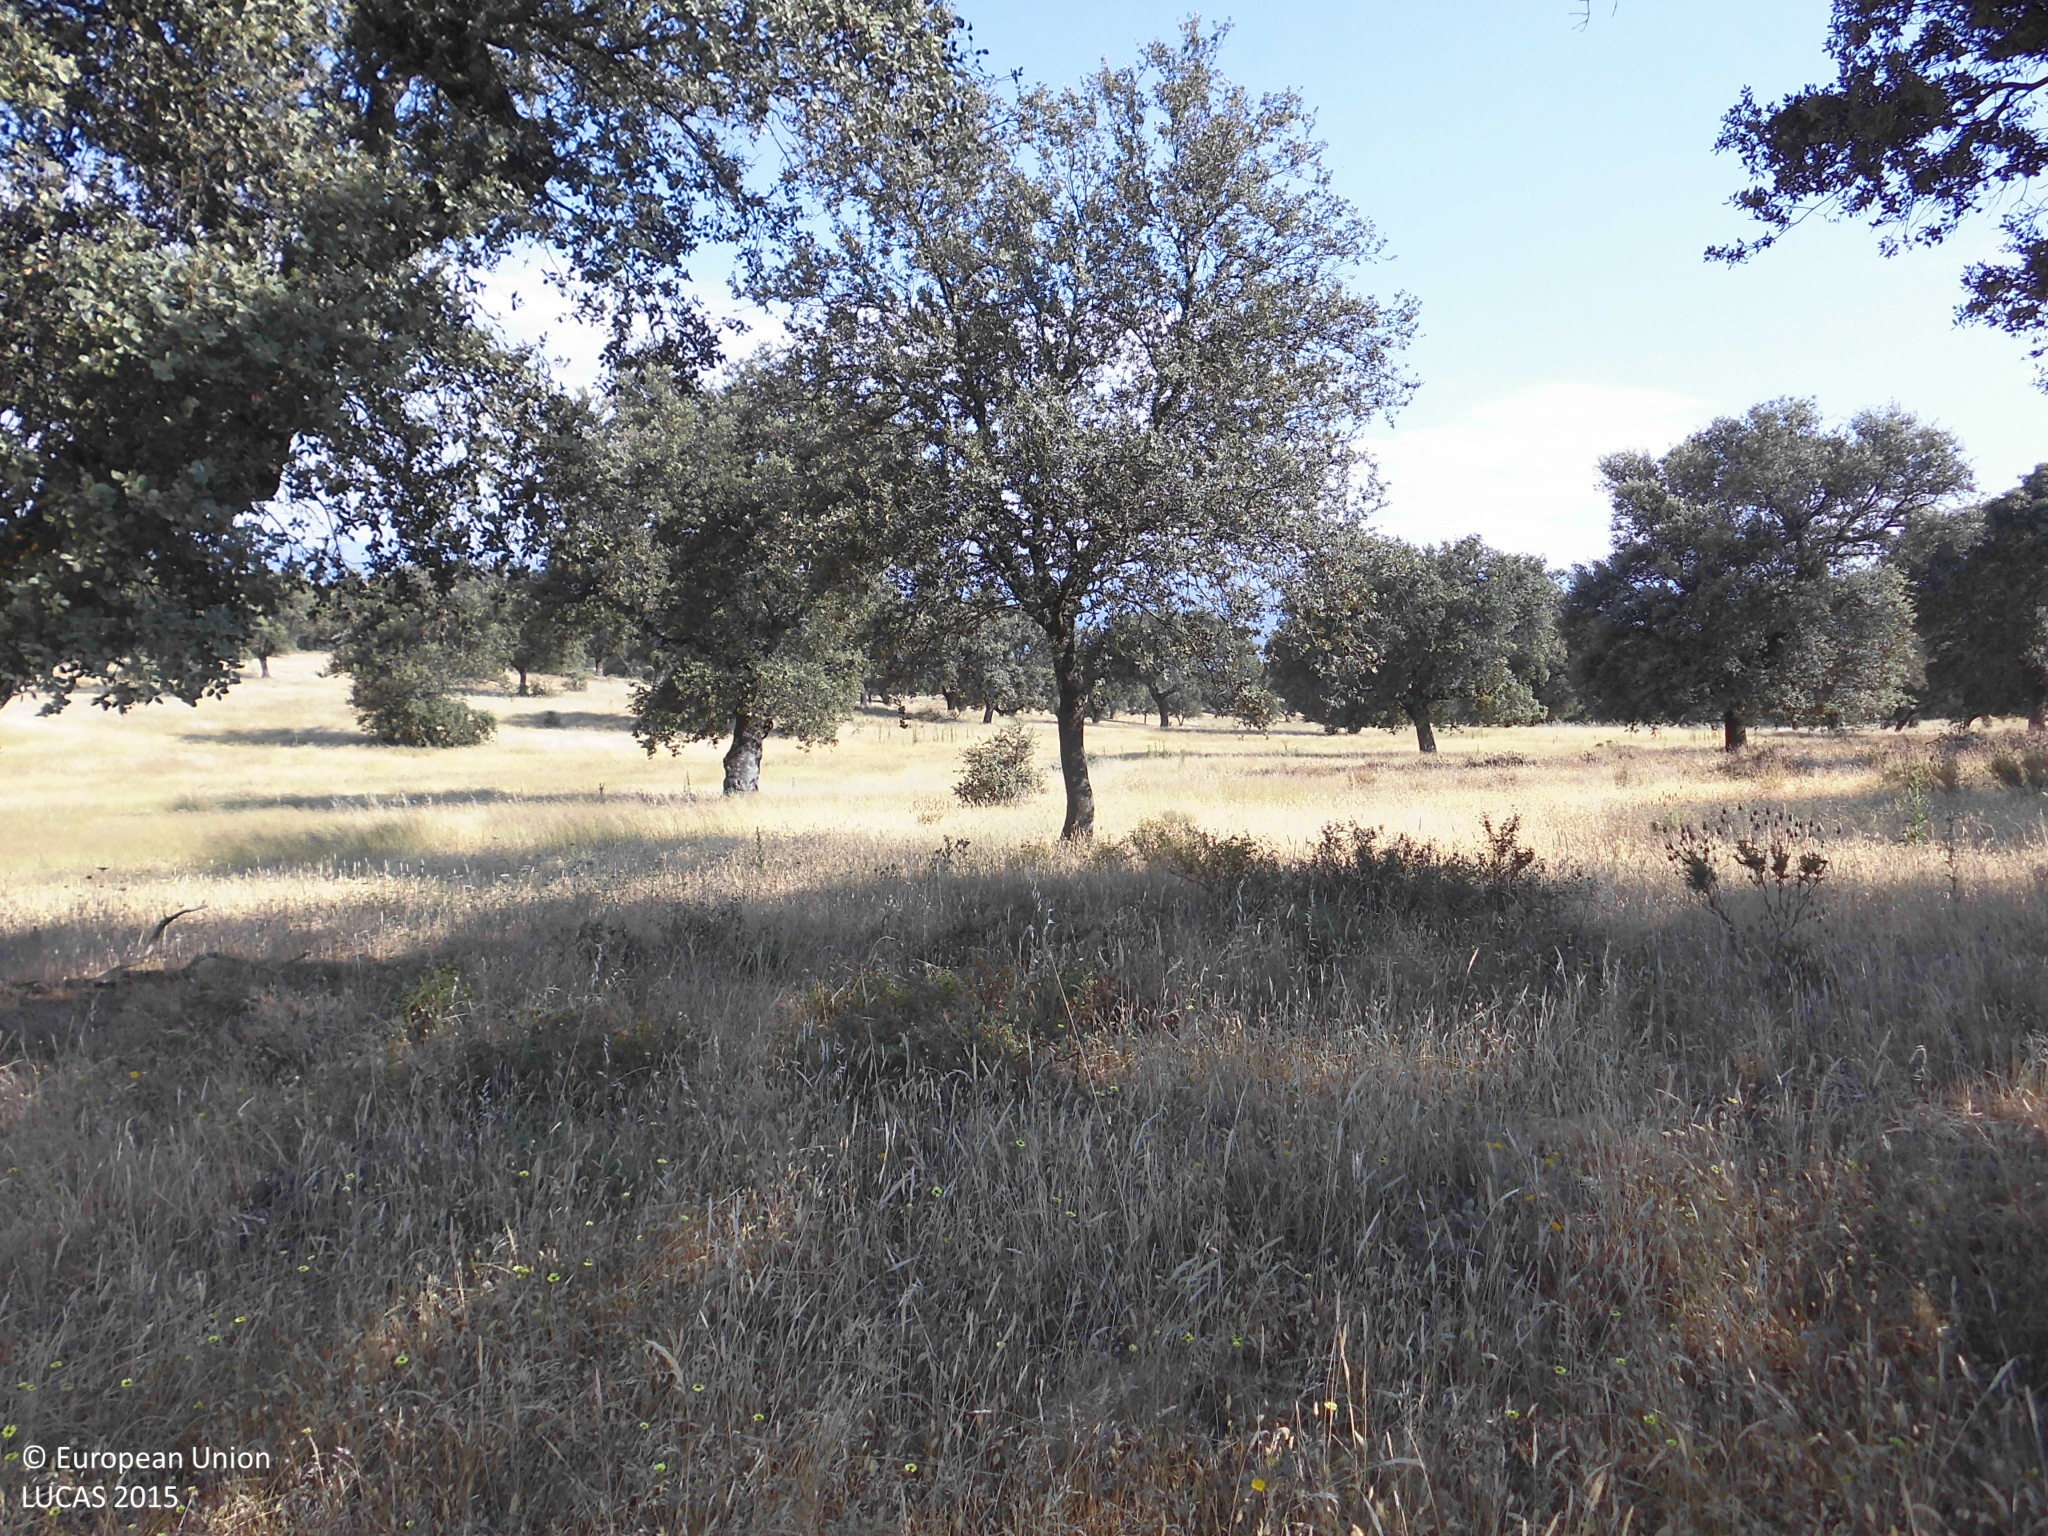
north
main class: Woodland
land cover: Broadleaved woodland
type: broadleaved evergreen forest
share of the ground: 50 - 75 %
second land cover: Grassland without tree/shrub cover
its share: > 75 %
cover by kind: herbaceous plants 70 %, broadleaved forest trees 25 %, shrubs 5 %
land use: Forestry
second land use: Agriculture (excluding fallow land and kitchen gardens)
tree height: > 5 m
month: June
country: ES
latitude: 40.0322
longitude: -5.4222
